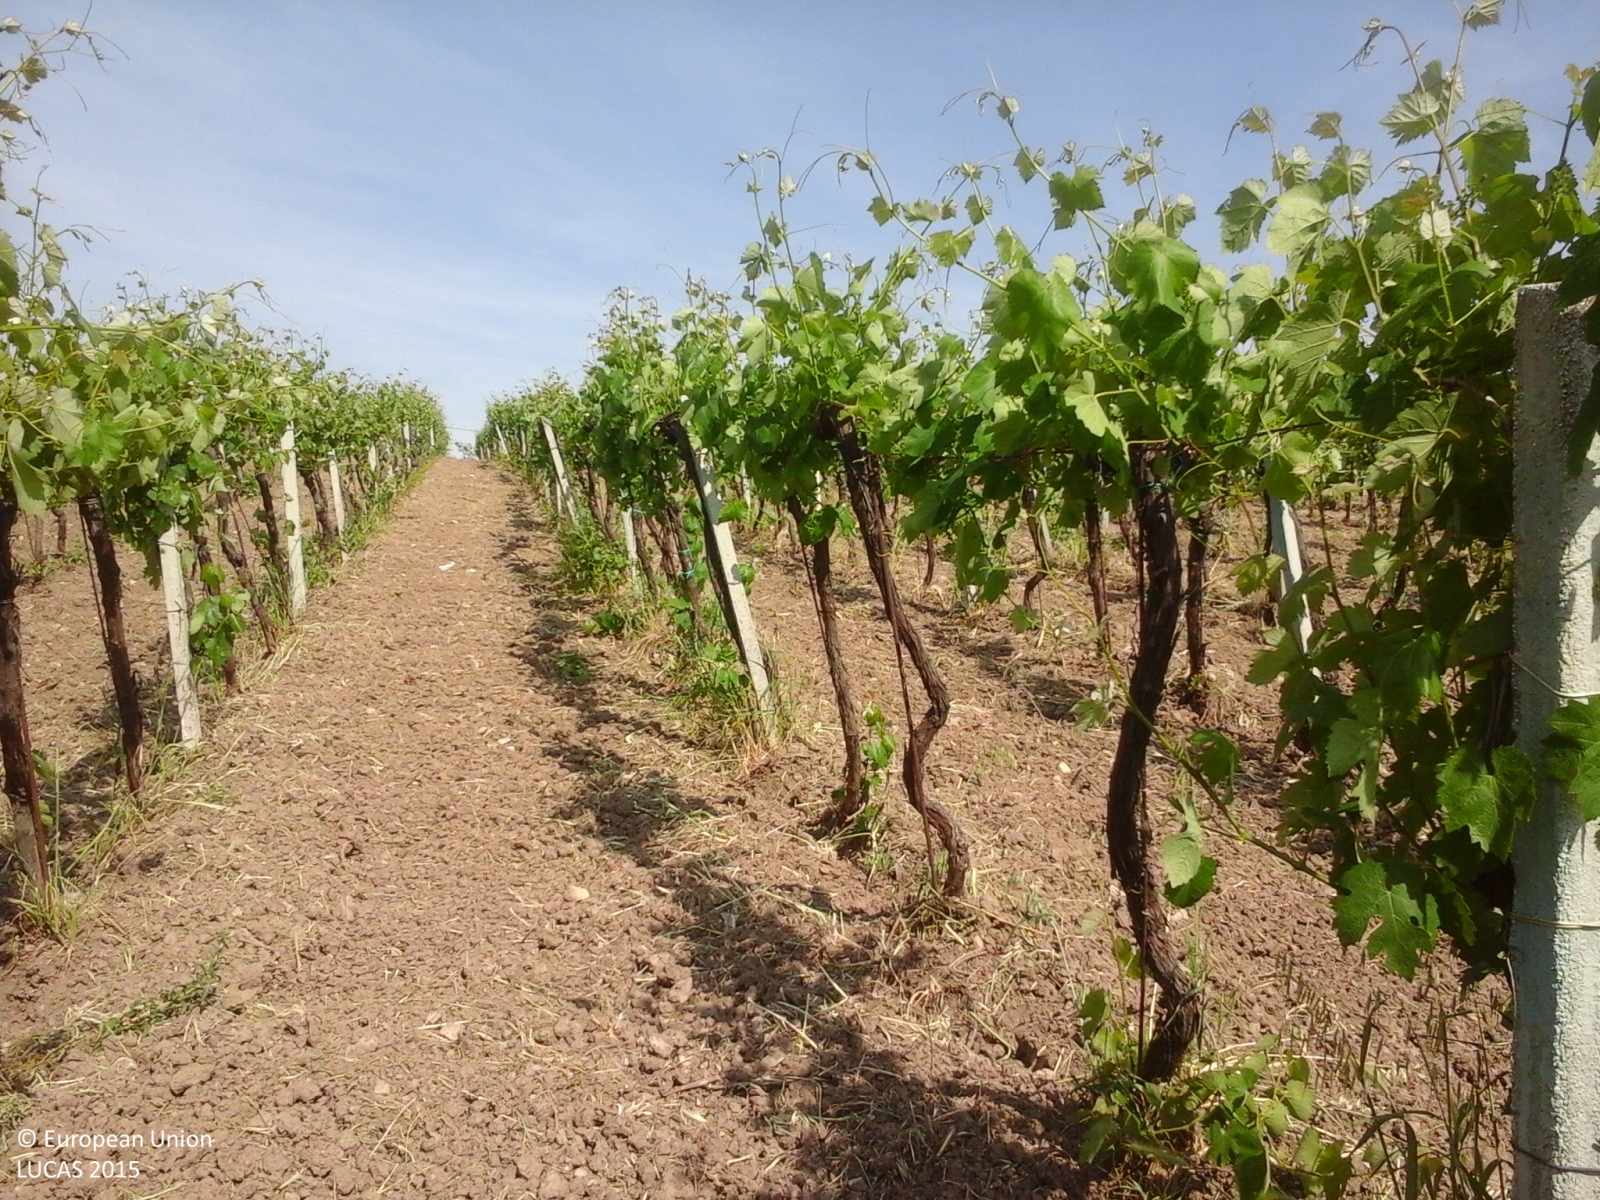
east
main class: Cropland
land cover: Vineyards
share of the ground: 50 - 75 %
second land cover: Other bare soil
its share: > 75 %
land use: Agriculture (excluding fallow land and kitchen gardens)
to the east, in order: Vineyards; Other bare soil; Shruby margins; Grass margins; Electric lines; Paved roads, cycling and walking lanes; Artificial constructions; Grass margins; Olive groves; Electric lines; Grass margins; Paved roads, cycling and walking lanes; Grass margins; Ditches and canals; Other bare soil
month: May
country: IT
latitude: 41.2240
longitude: 14.6944
